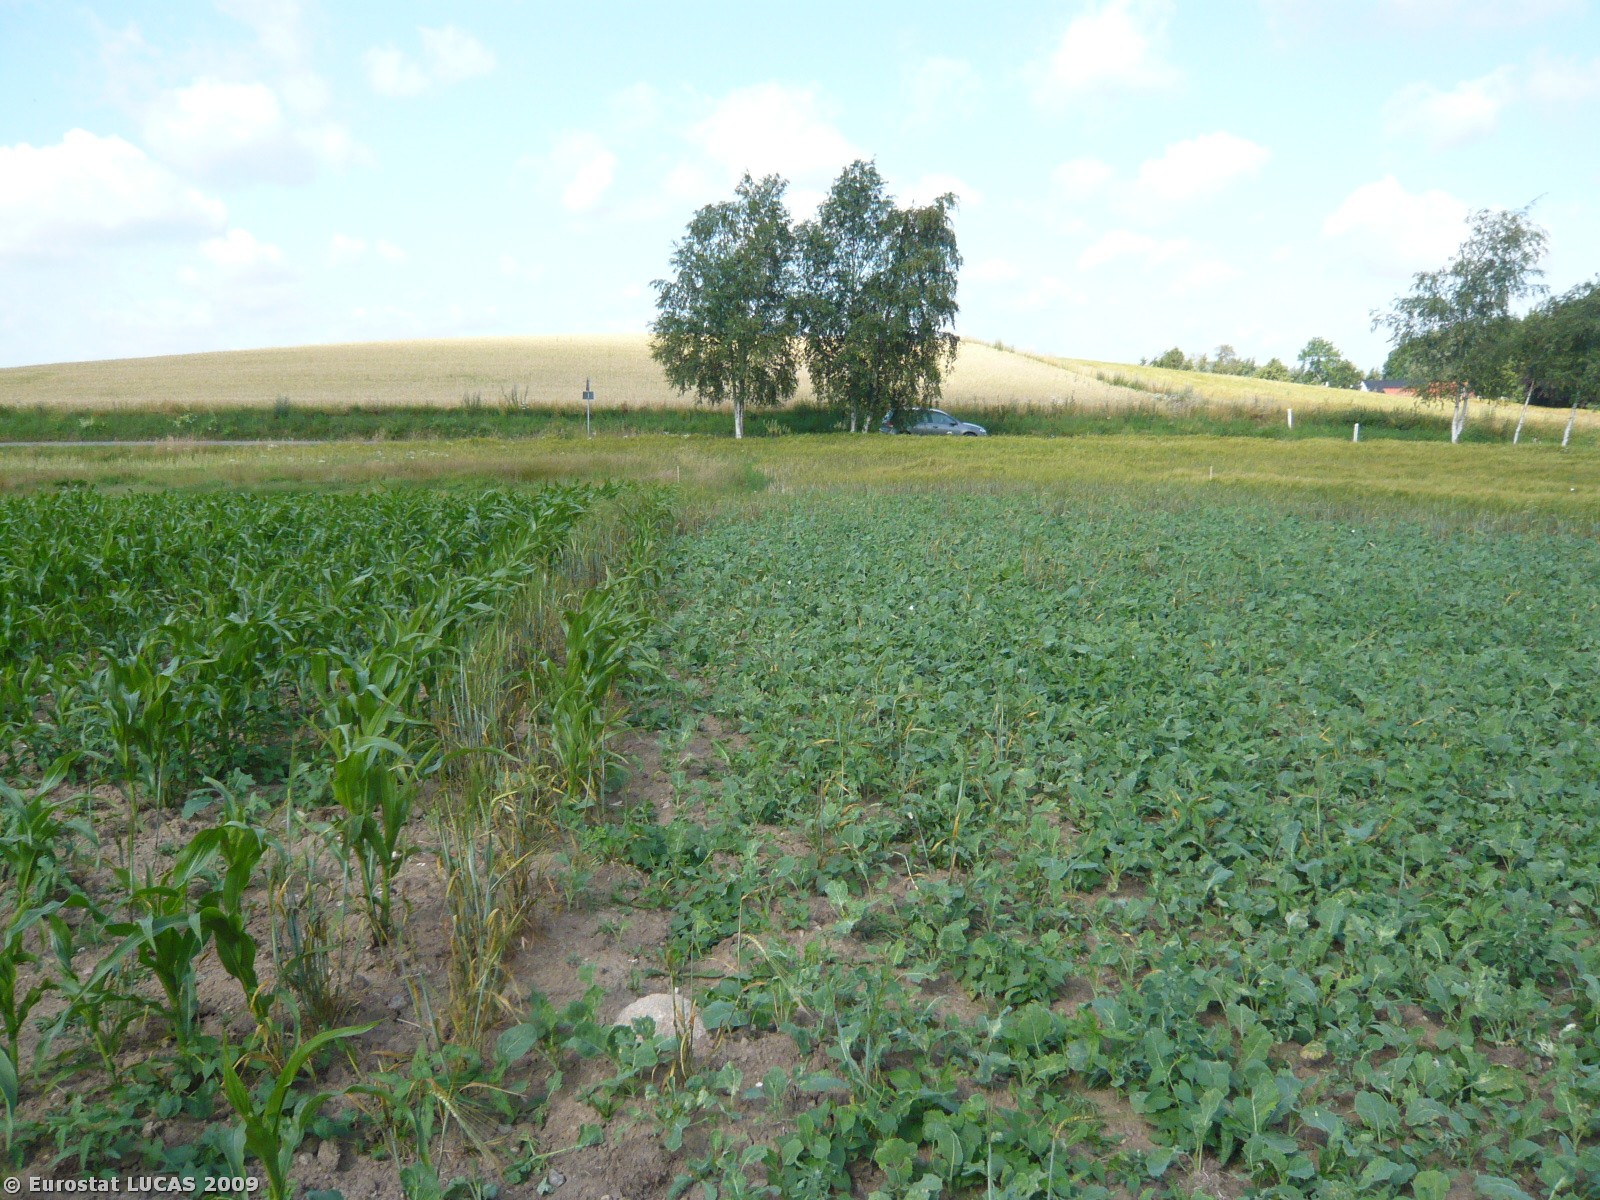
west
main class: Cropland
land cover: Barley
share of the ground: 25 - 50 %
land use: Agriculture (excluding fallow land and kitchen gardens)
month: July
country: DK
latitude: 55.6564
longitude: 11.6038
